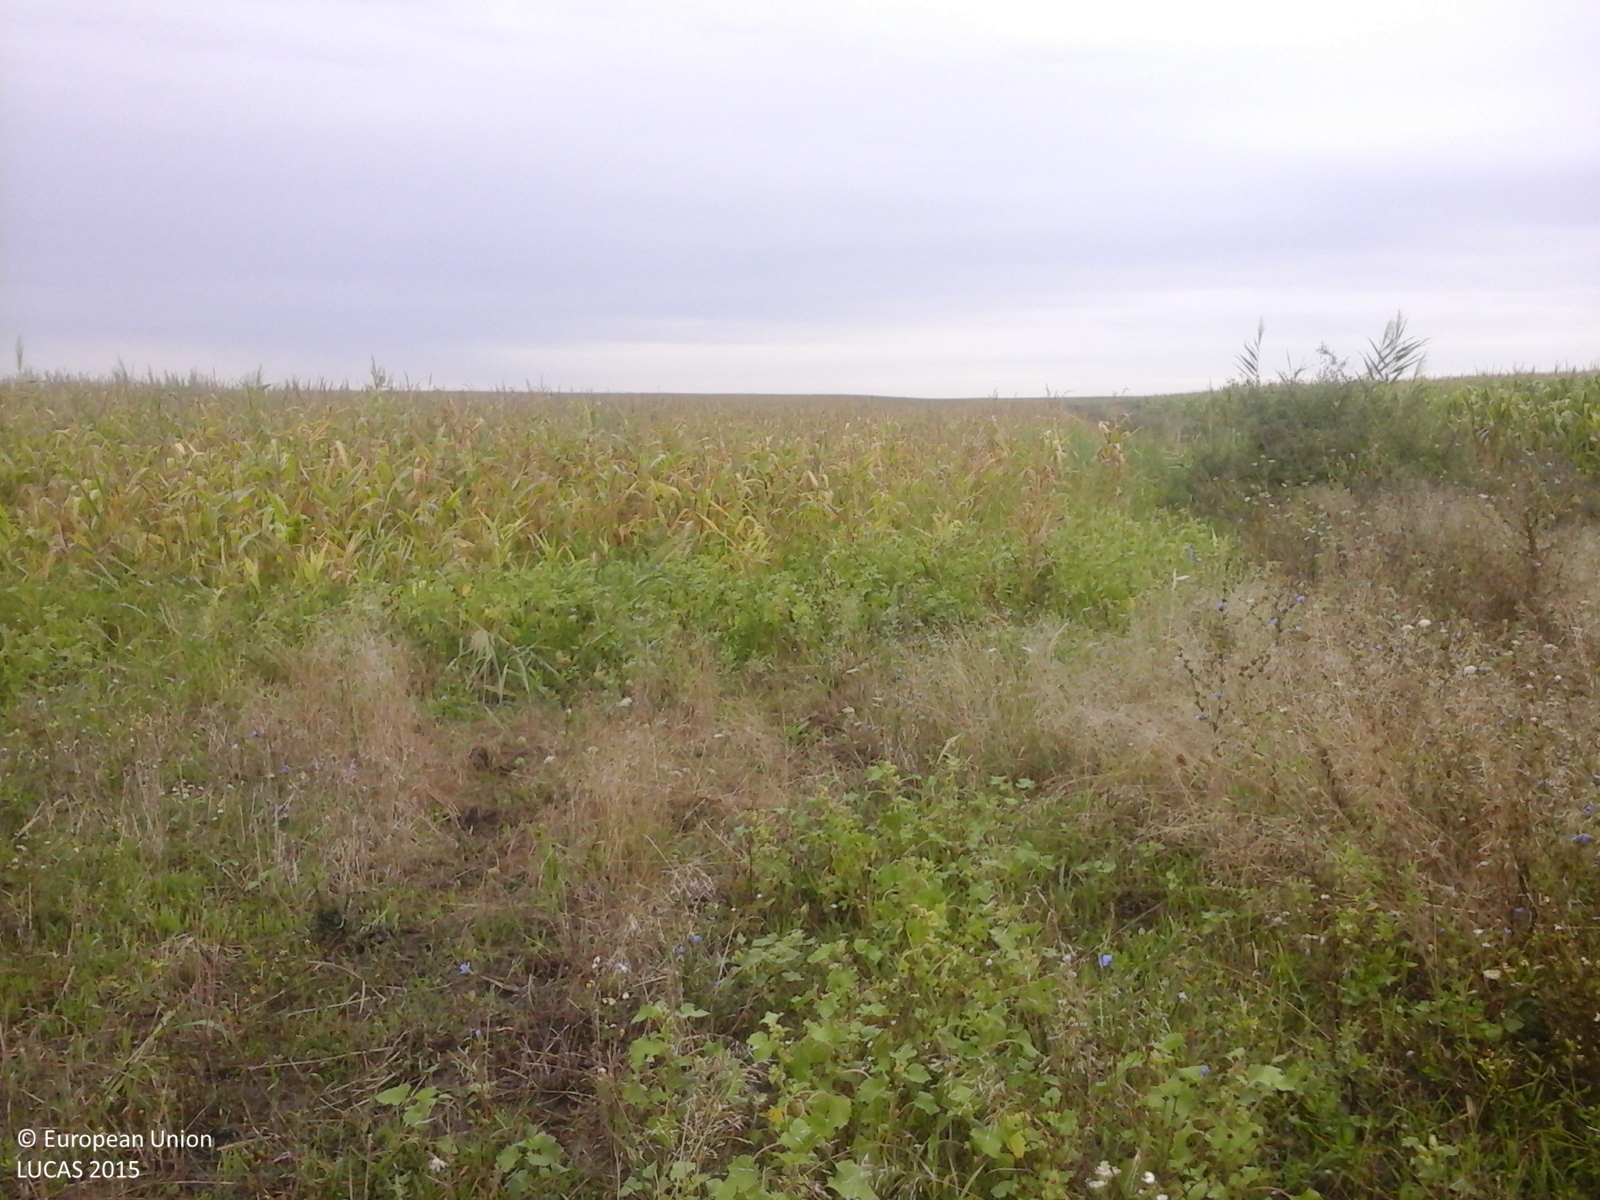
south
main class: Cropland
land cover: Maize
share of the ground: > 75 %
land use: Agriculture (excluding fallow land and kitchen gardens)
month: August
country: RO
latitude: 45.4405
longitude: 21.1372
